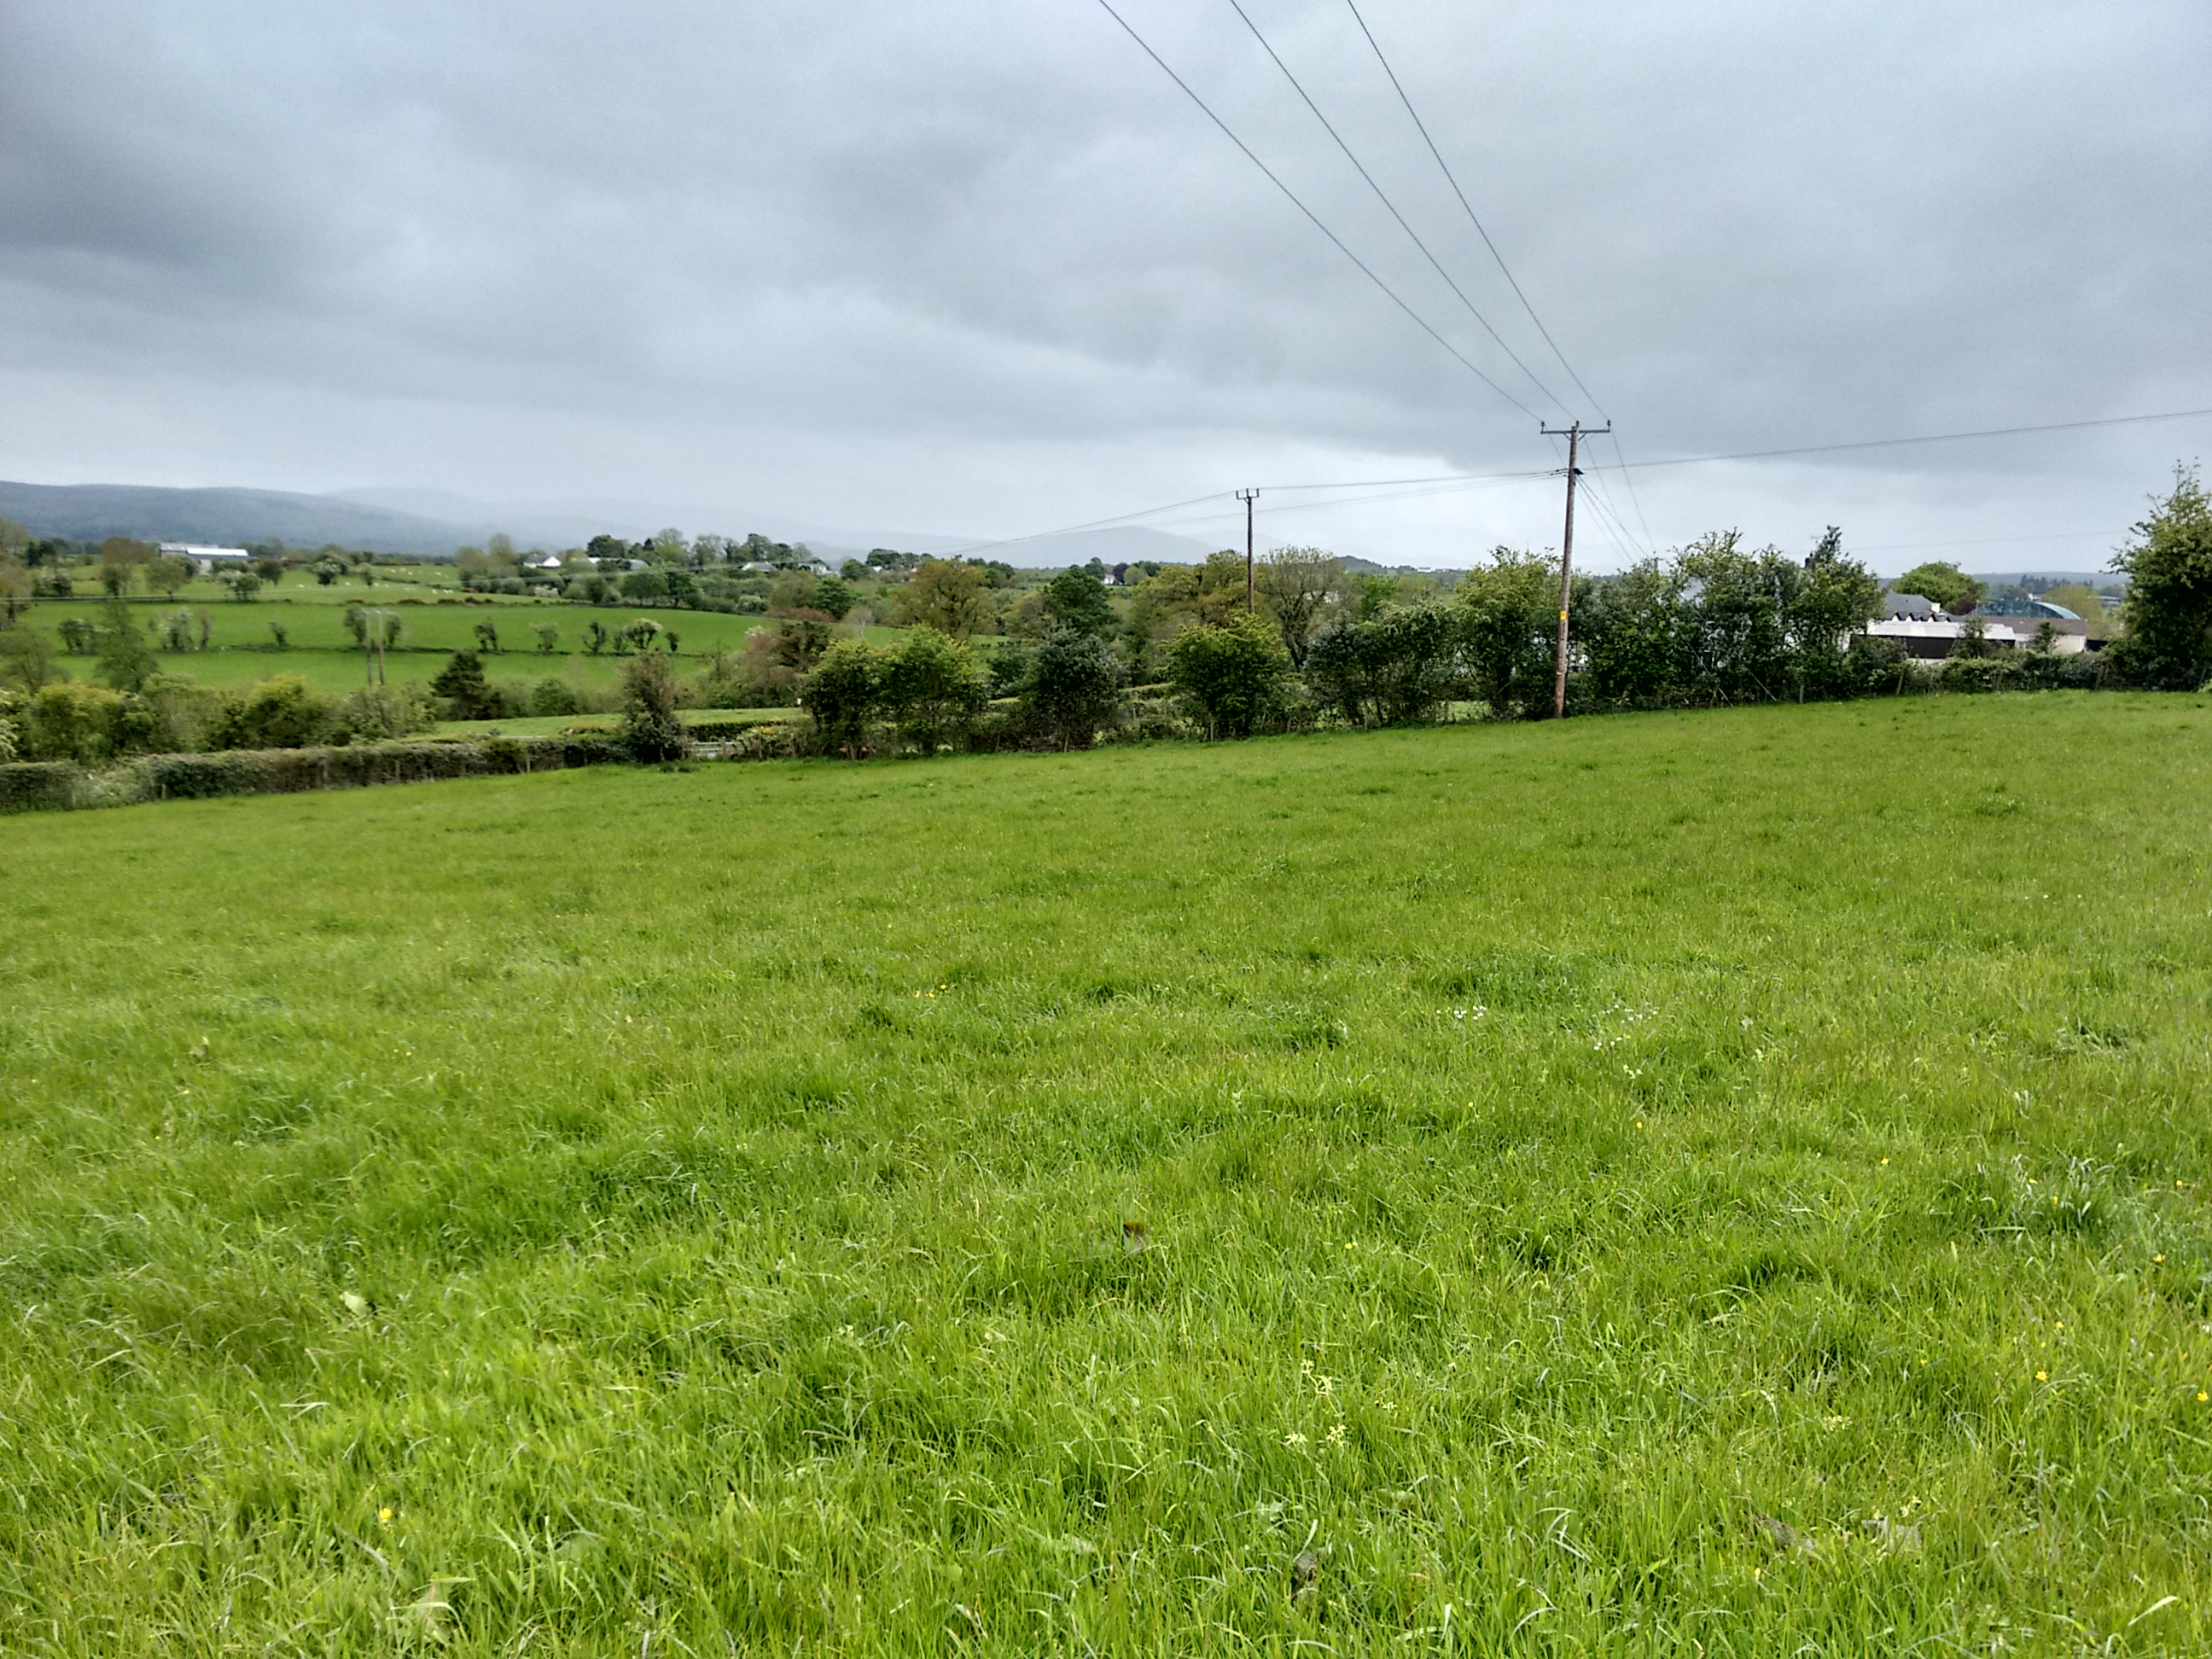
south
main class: Grassland
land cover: Grassland without tree/shrub cover
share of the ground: > 75 %
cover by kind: herbaceous plants 100 %
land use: Agriculture (excluding fallow land and kitchen gardens)
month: June
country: GB
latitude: 54.9546
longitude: -6.9543
